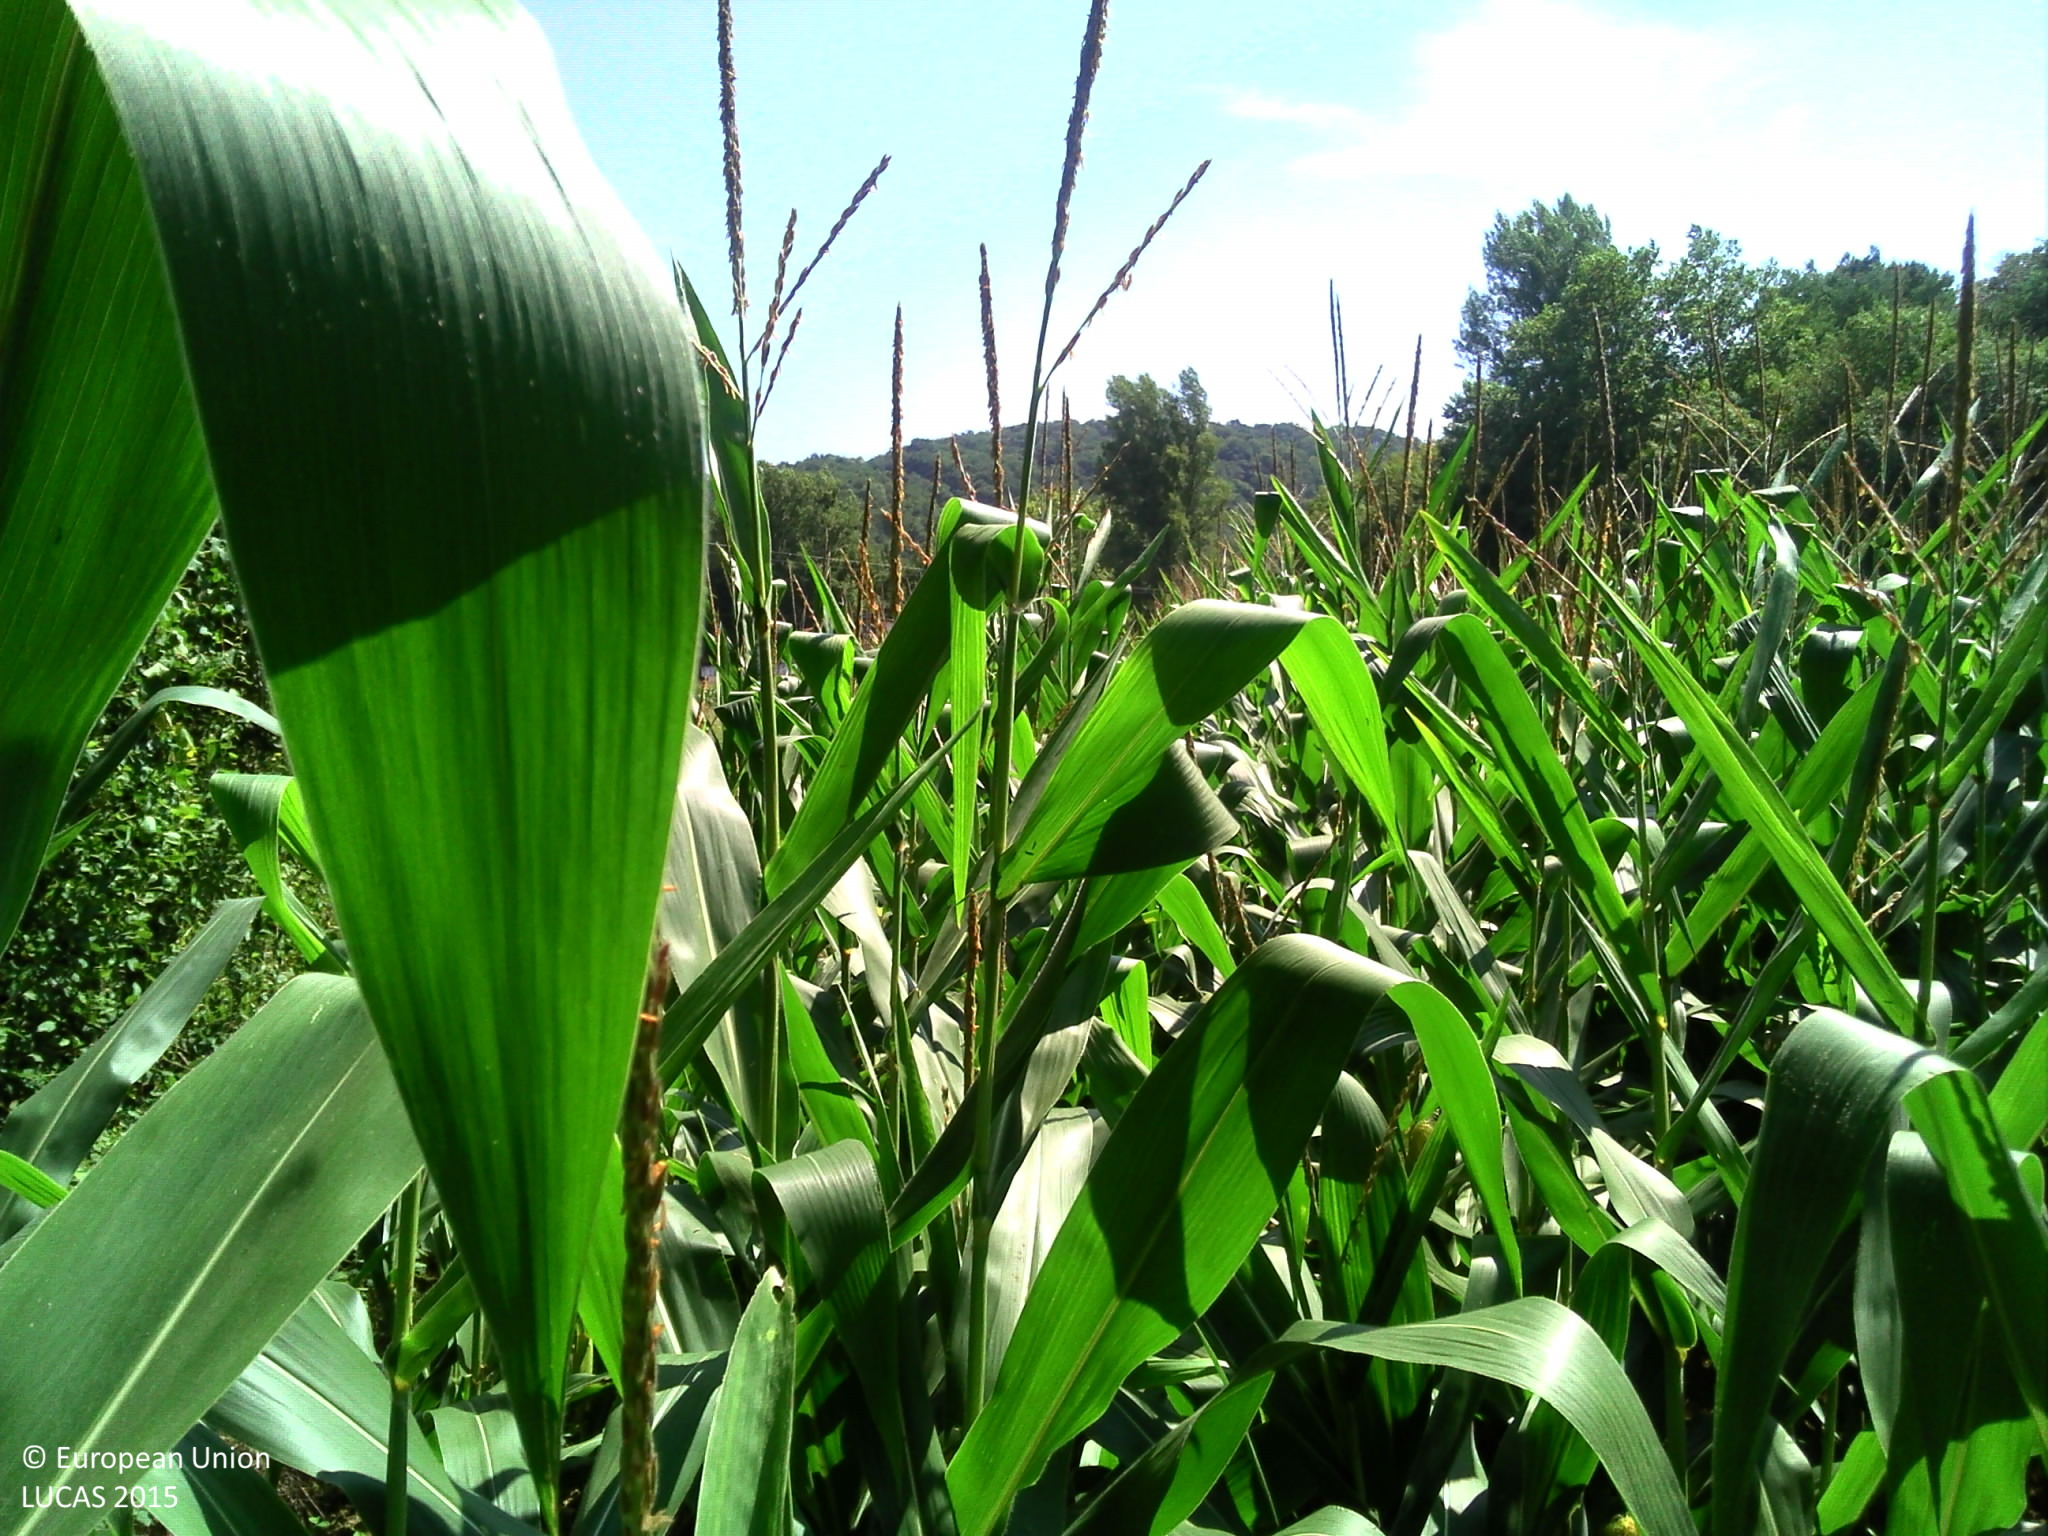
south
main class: Cropland
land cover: Maize
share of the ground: > 75 %
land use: Agriculture (excluding fallow land and kitchen gardens)
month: August
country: FR
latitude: 43.3220
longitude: -1.0493
